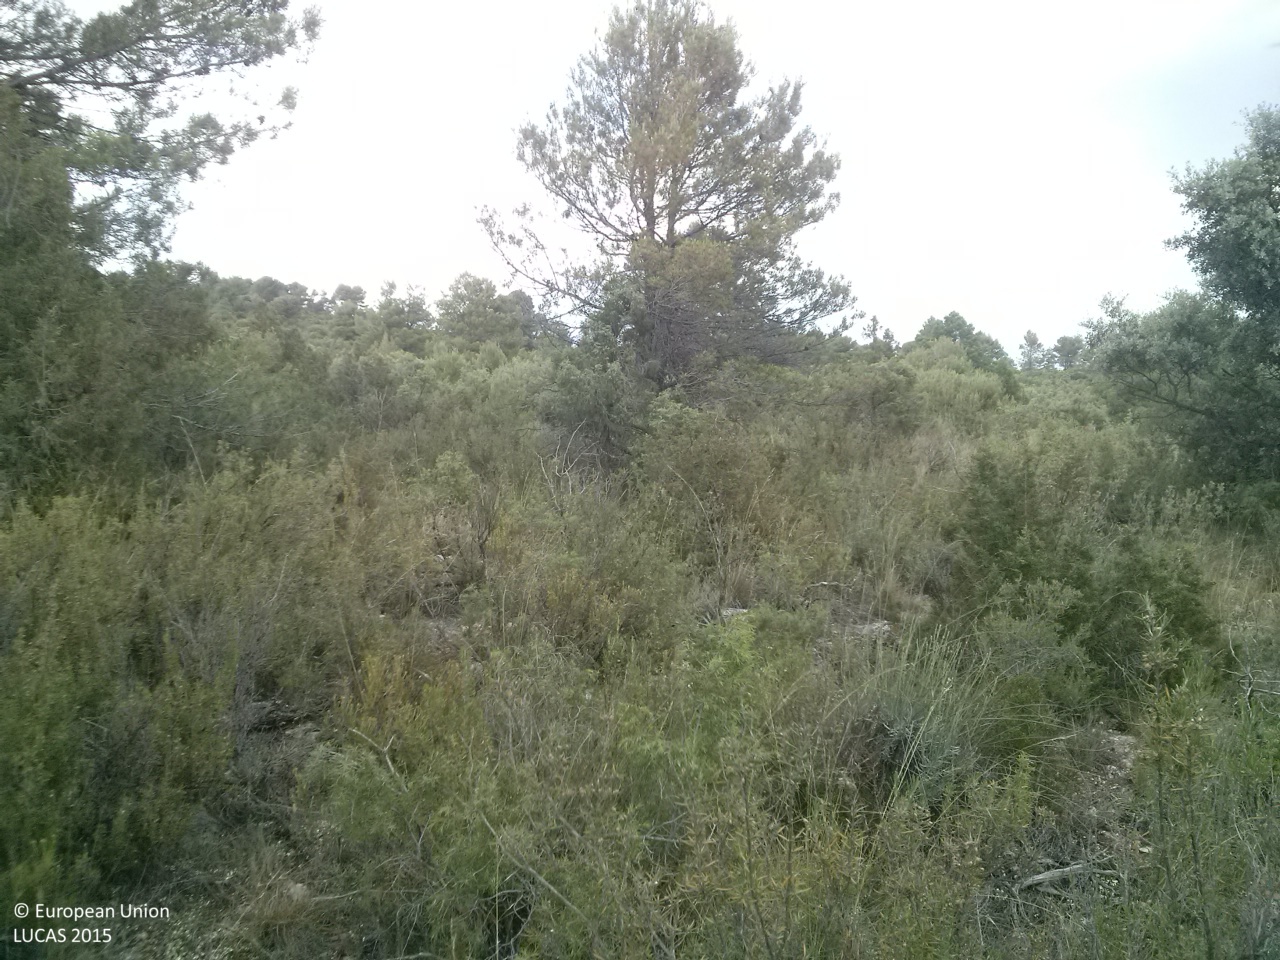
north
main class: Woodland
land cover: Pine dominated coniferous woodland
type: coniferous forest of the mediterranean region
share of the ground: 10 - 25 %
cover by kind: shrubs 50 %, coniferous forest trees 25 %, herbaceous plants 25 %
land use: Forestry
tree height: > 5 m
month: June
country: ES
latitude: 39.7580
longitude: -1.7629
